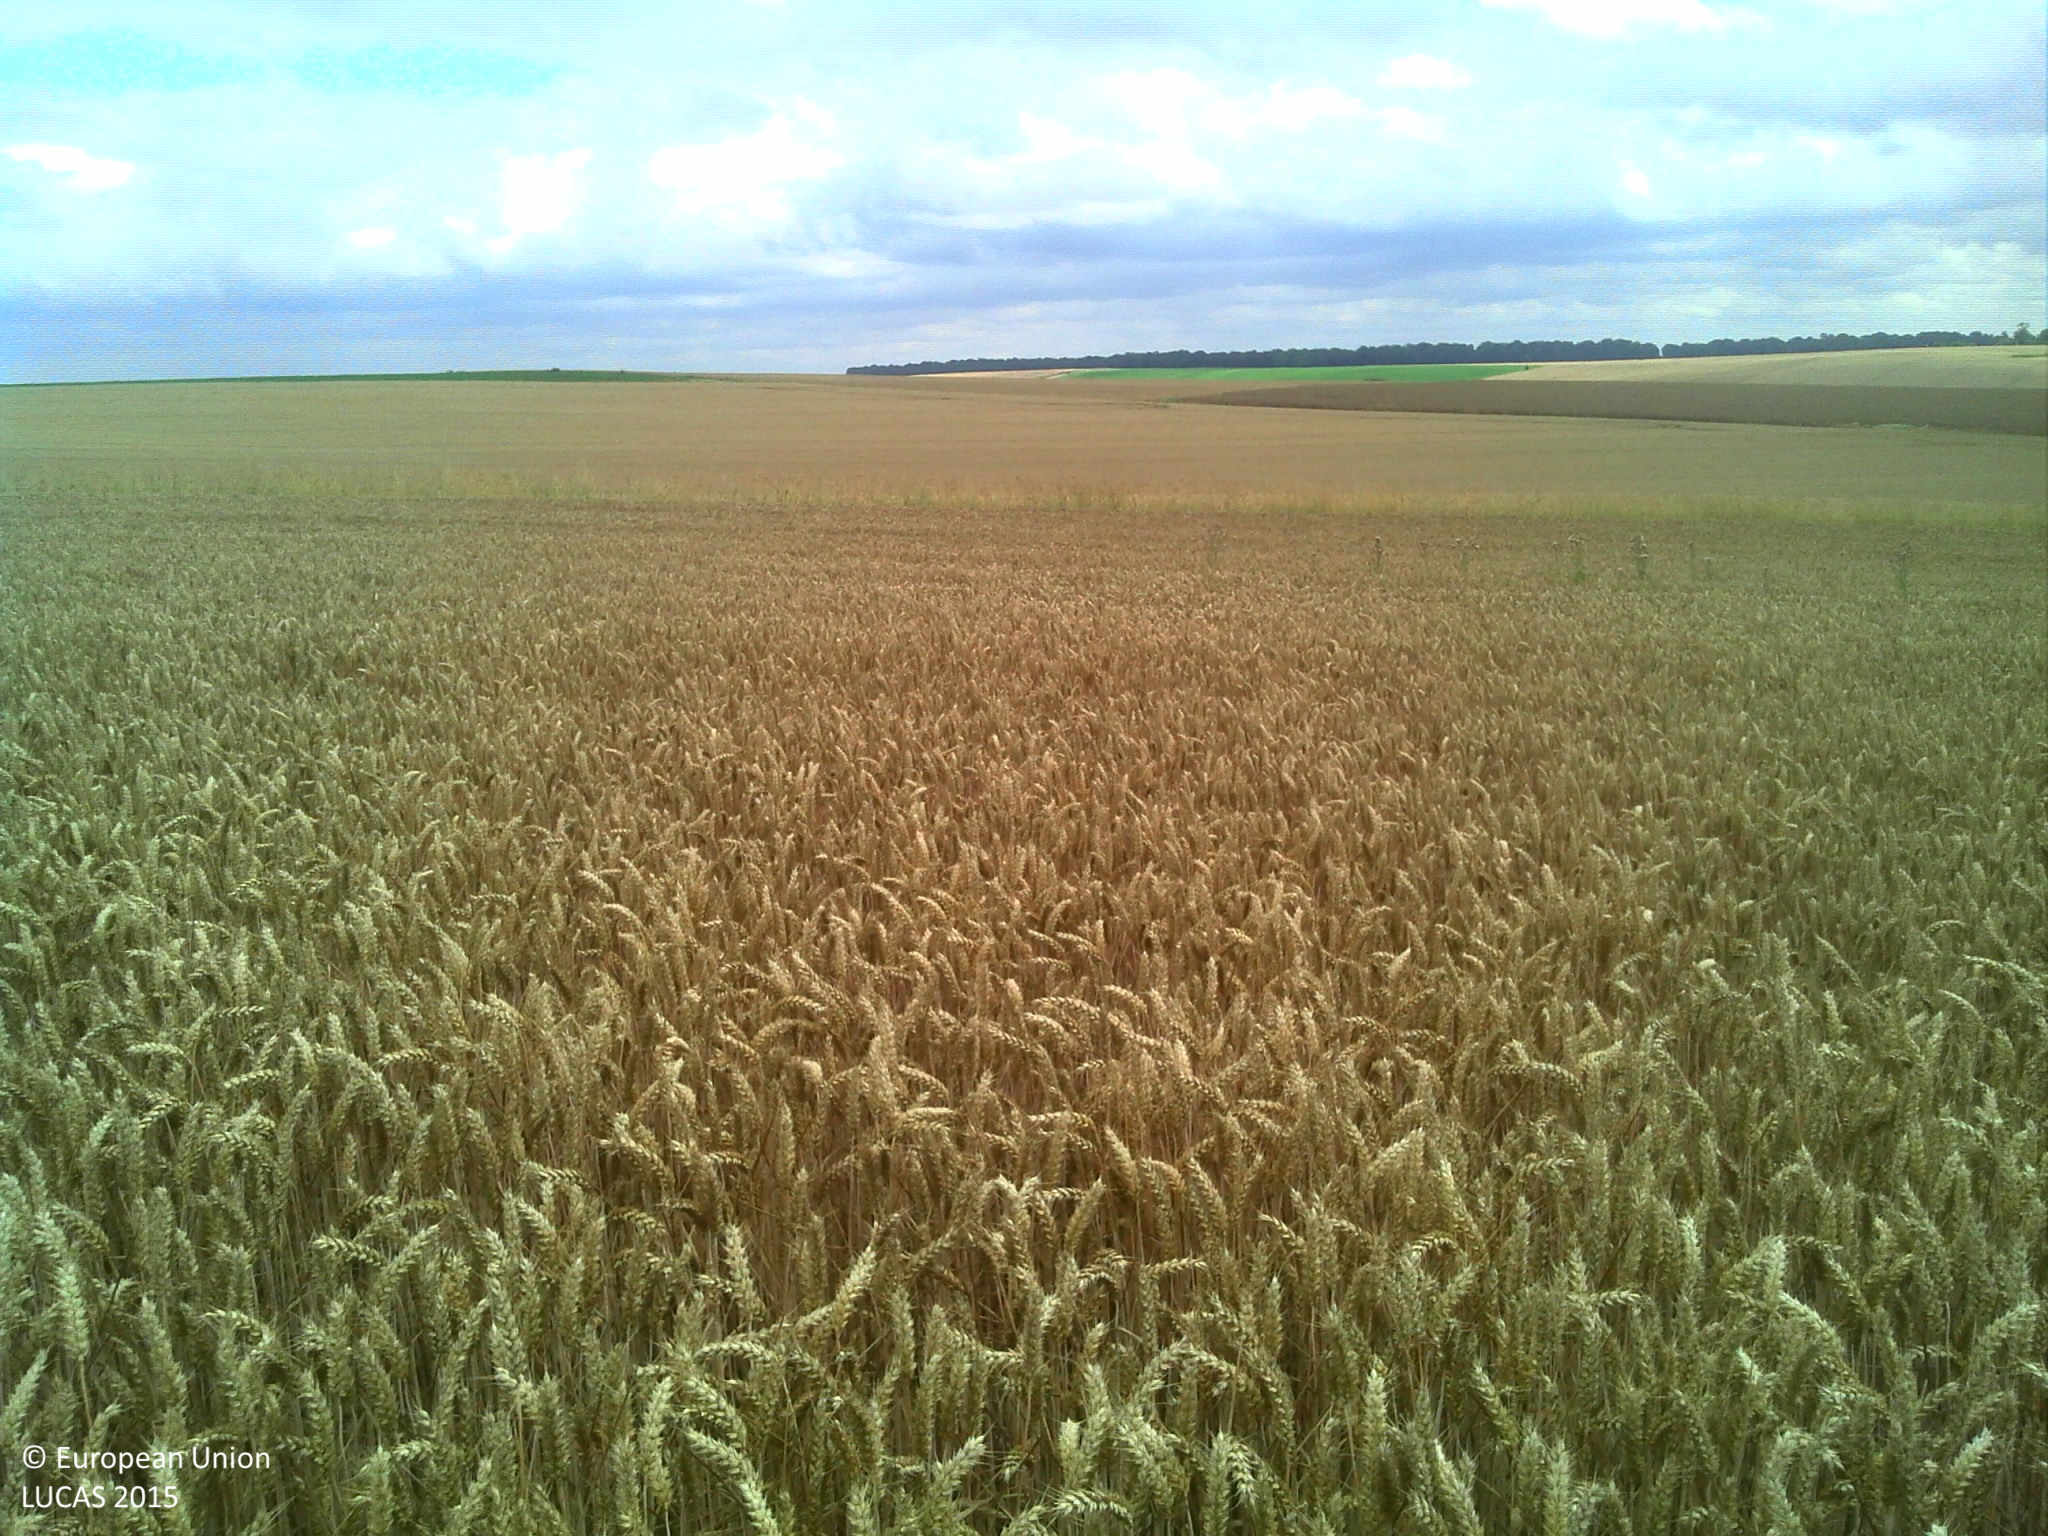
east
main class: Cropland
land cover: Common wheat
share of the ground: > 75 %
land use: Agriculture (excluding fallow land and kitchen gardens)
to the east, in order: Common wheat; Grass margins; Maize; Common wheat
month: July
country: FR
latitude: 49.8621
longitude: 3.6357
